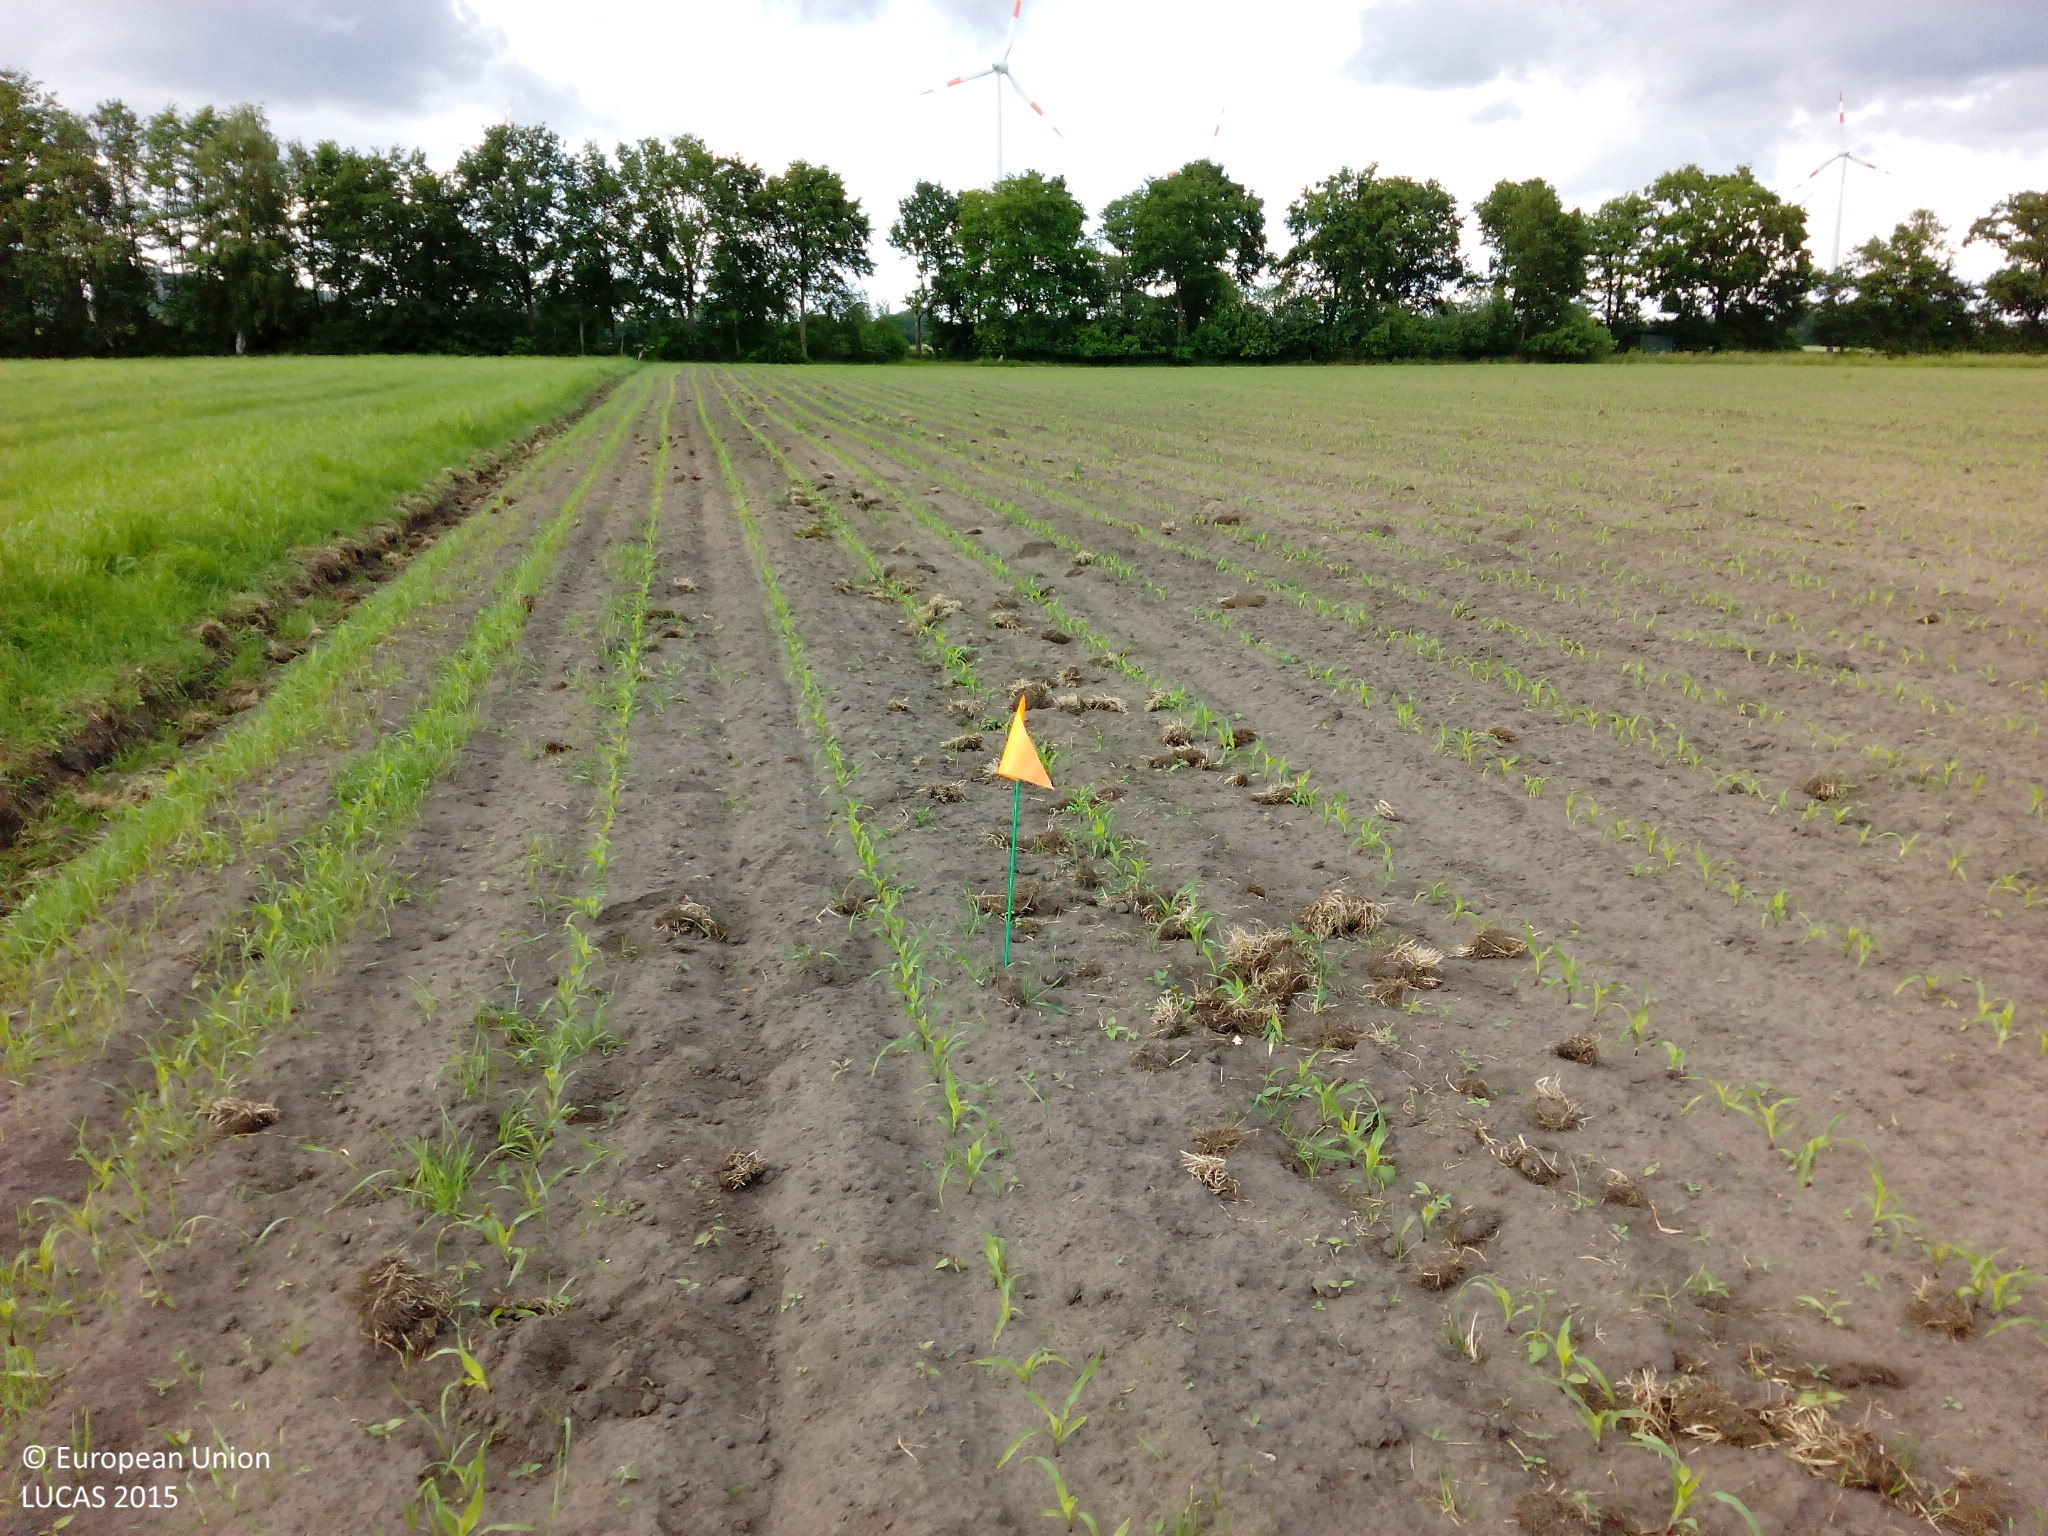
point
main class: Cropland
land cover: Maize
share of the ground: > 75 %
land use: Agriculture (excluding fallow land and kitchen gardens)
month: June
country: DE
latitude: 52.6358
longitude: 7.3554
